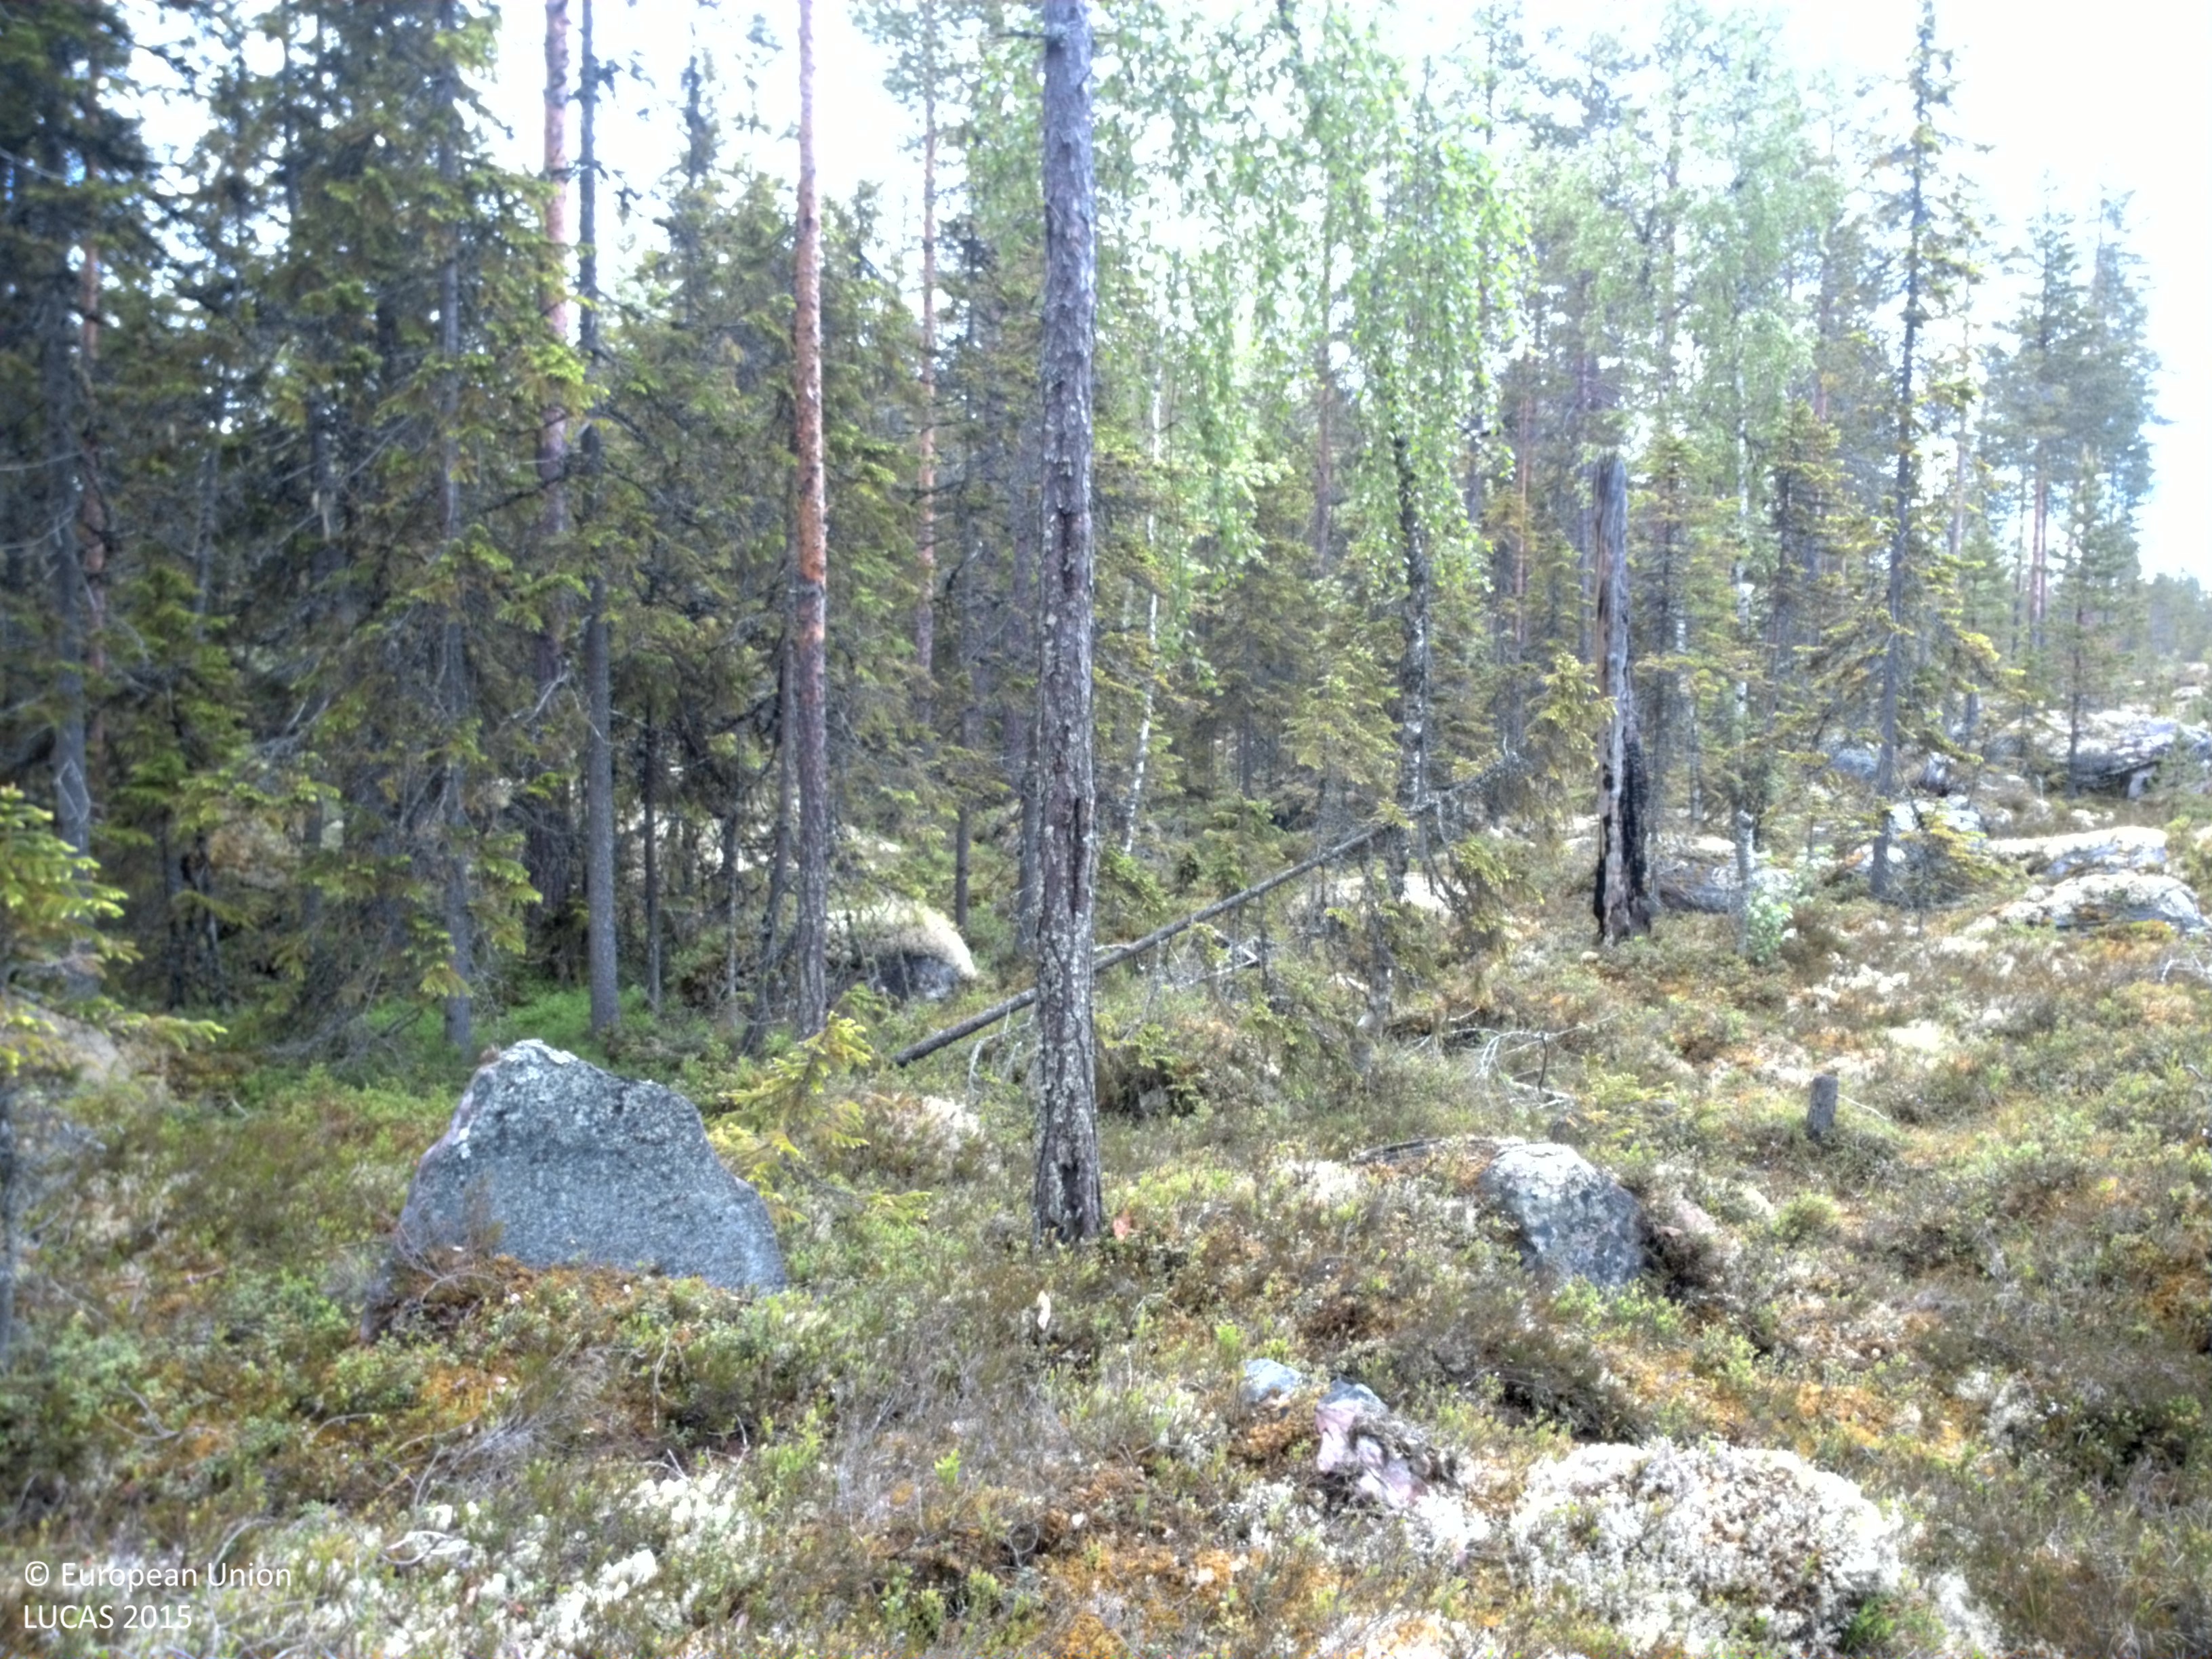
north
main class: Woodland
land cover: Pine dominated coniferous woodland
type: boreal forest
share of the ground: 50 - 75 %
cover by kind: coniferous forest trees 55 %, lichens and mosses 25 %, herbaceous plants 15 %, consolidated bare surface 5 %
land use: Forestry
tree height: > 5 m
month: June
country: SE
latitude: 61.4019
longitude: 13.3776
